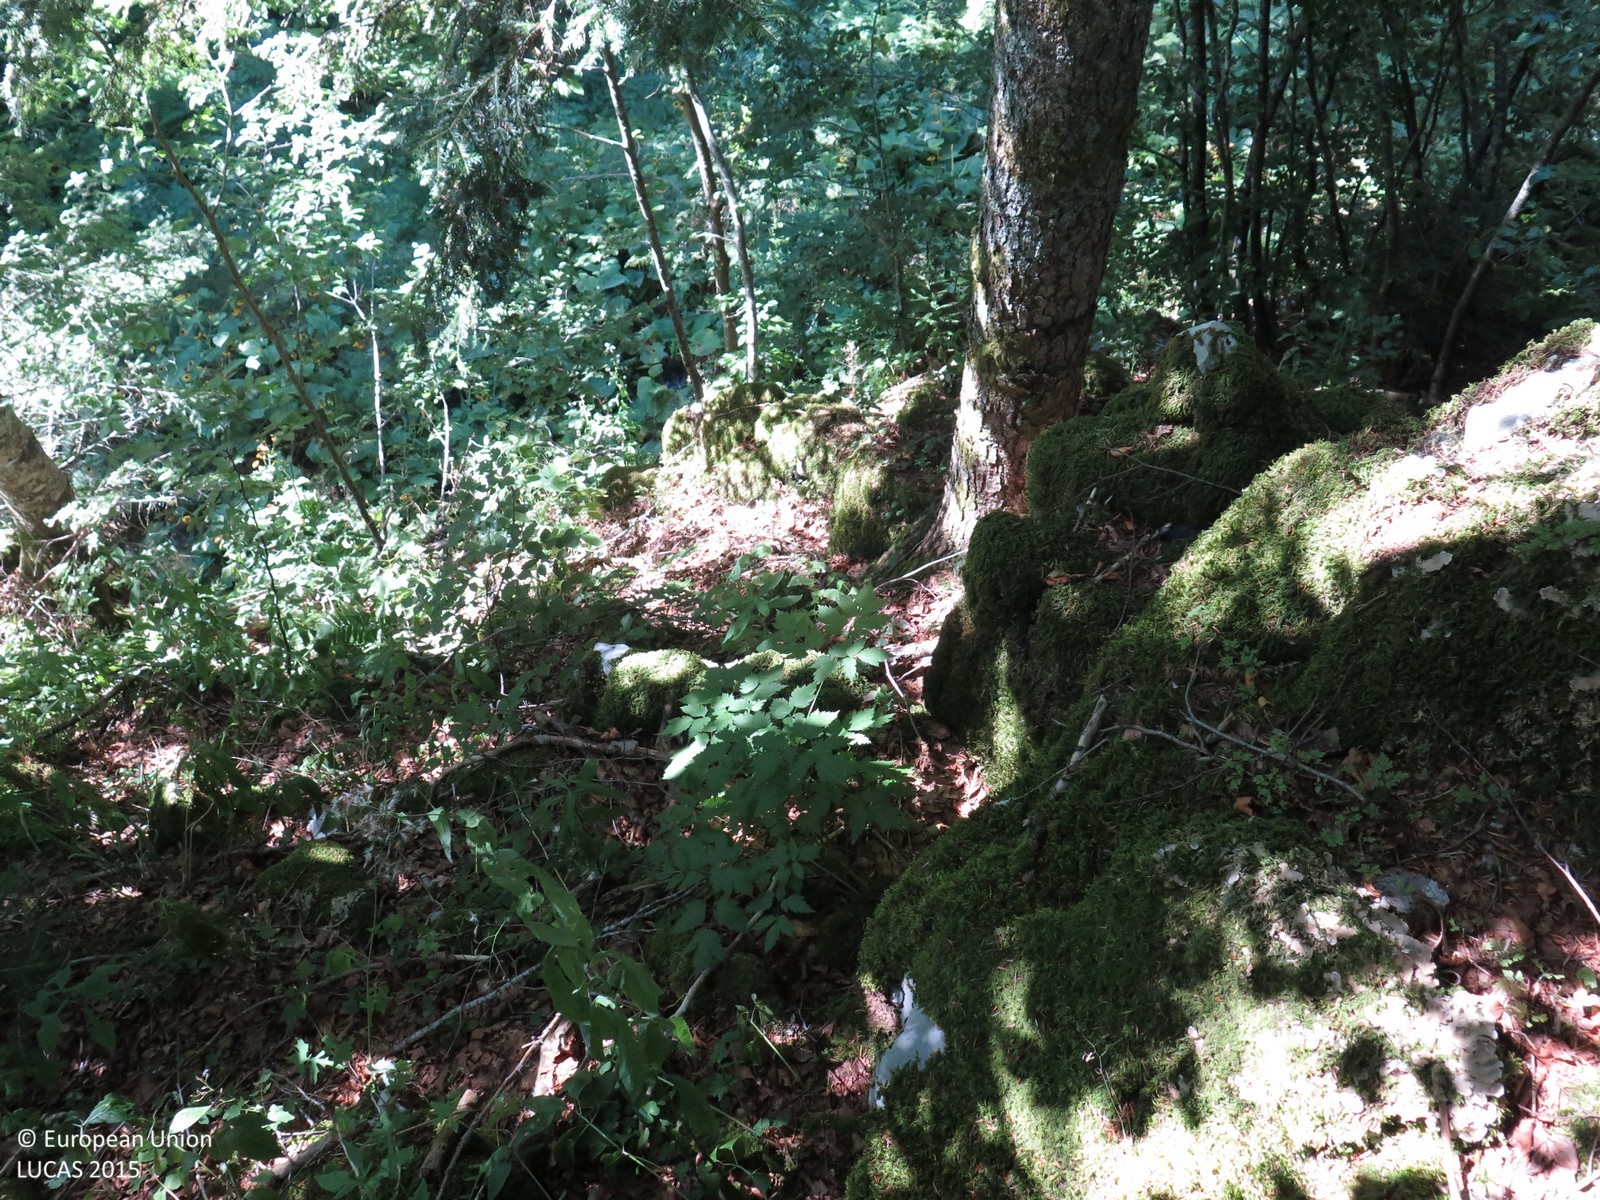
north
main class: Woodland
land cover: Other mixed woodland
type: mountainous beech forest
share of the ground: > 75 %
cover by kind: coniferous forest trees 75 %, broadleaved forest trees 25 %
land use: Forestry
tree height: > 5 m
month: August
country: HR
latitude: 45.2486
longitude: 14.8493
